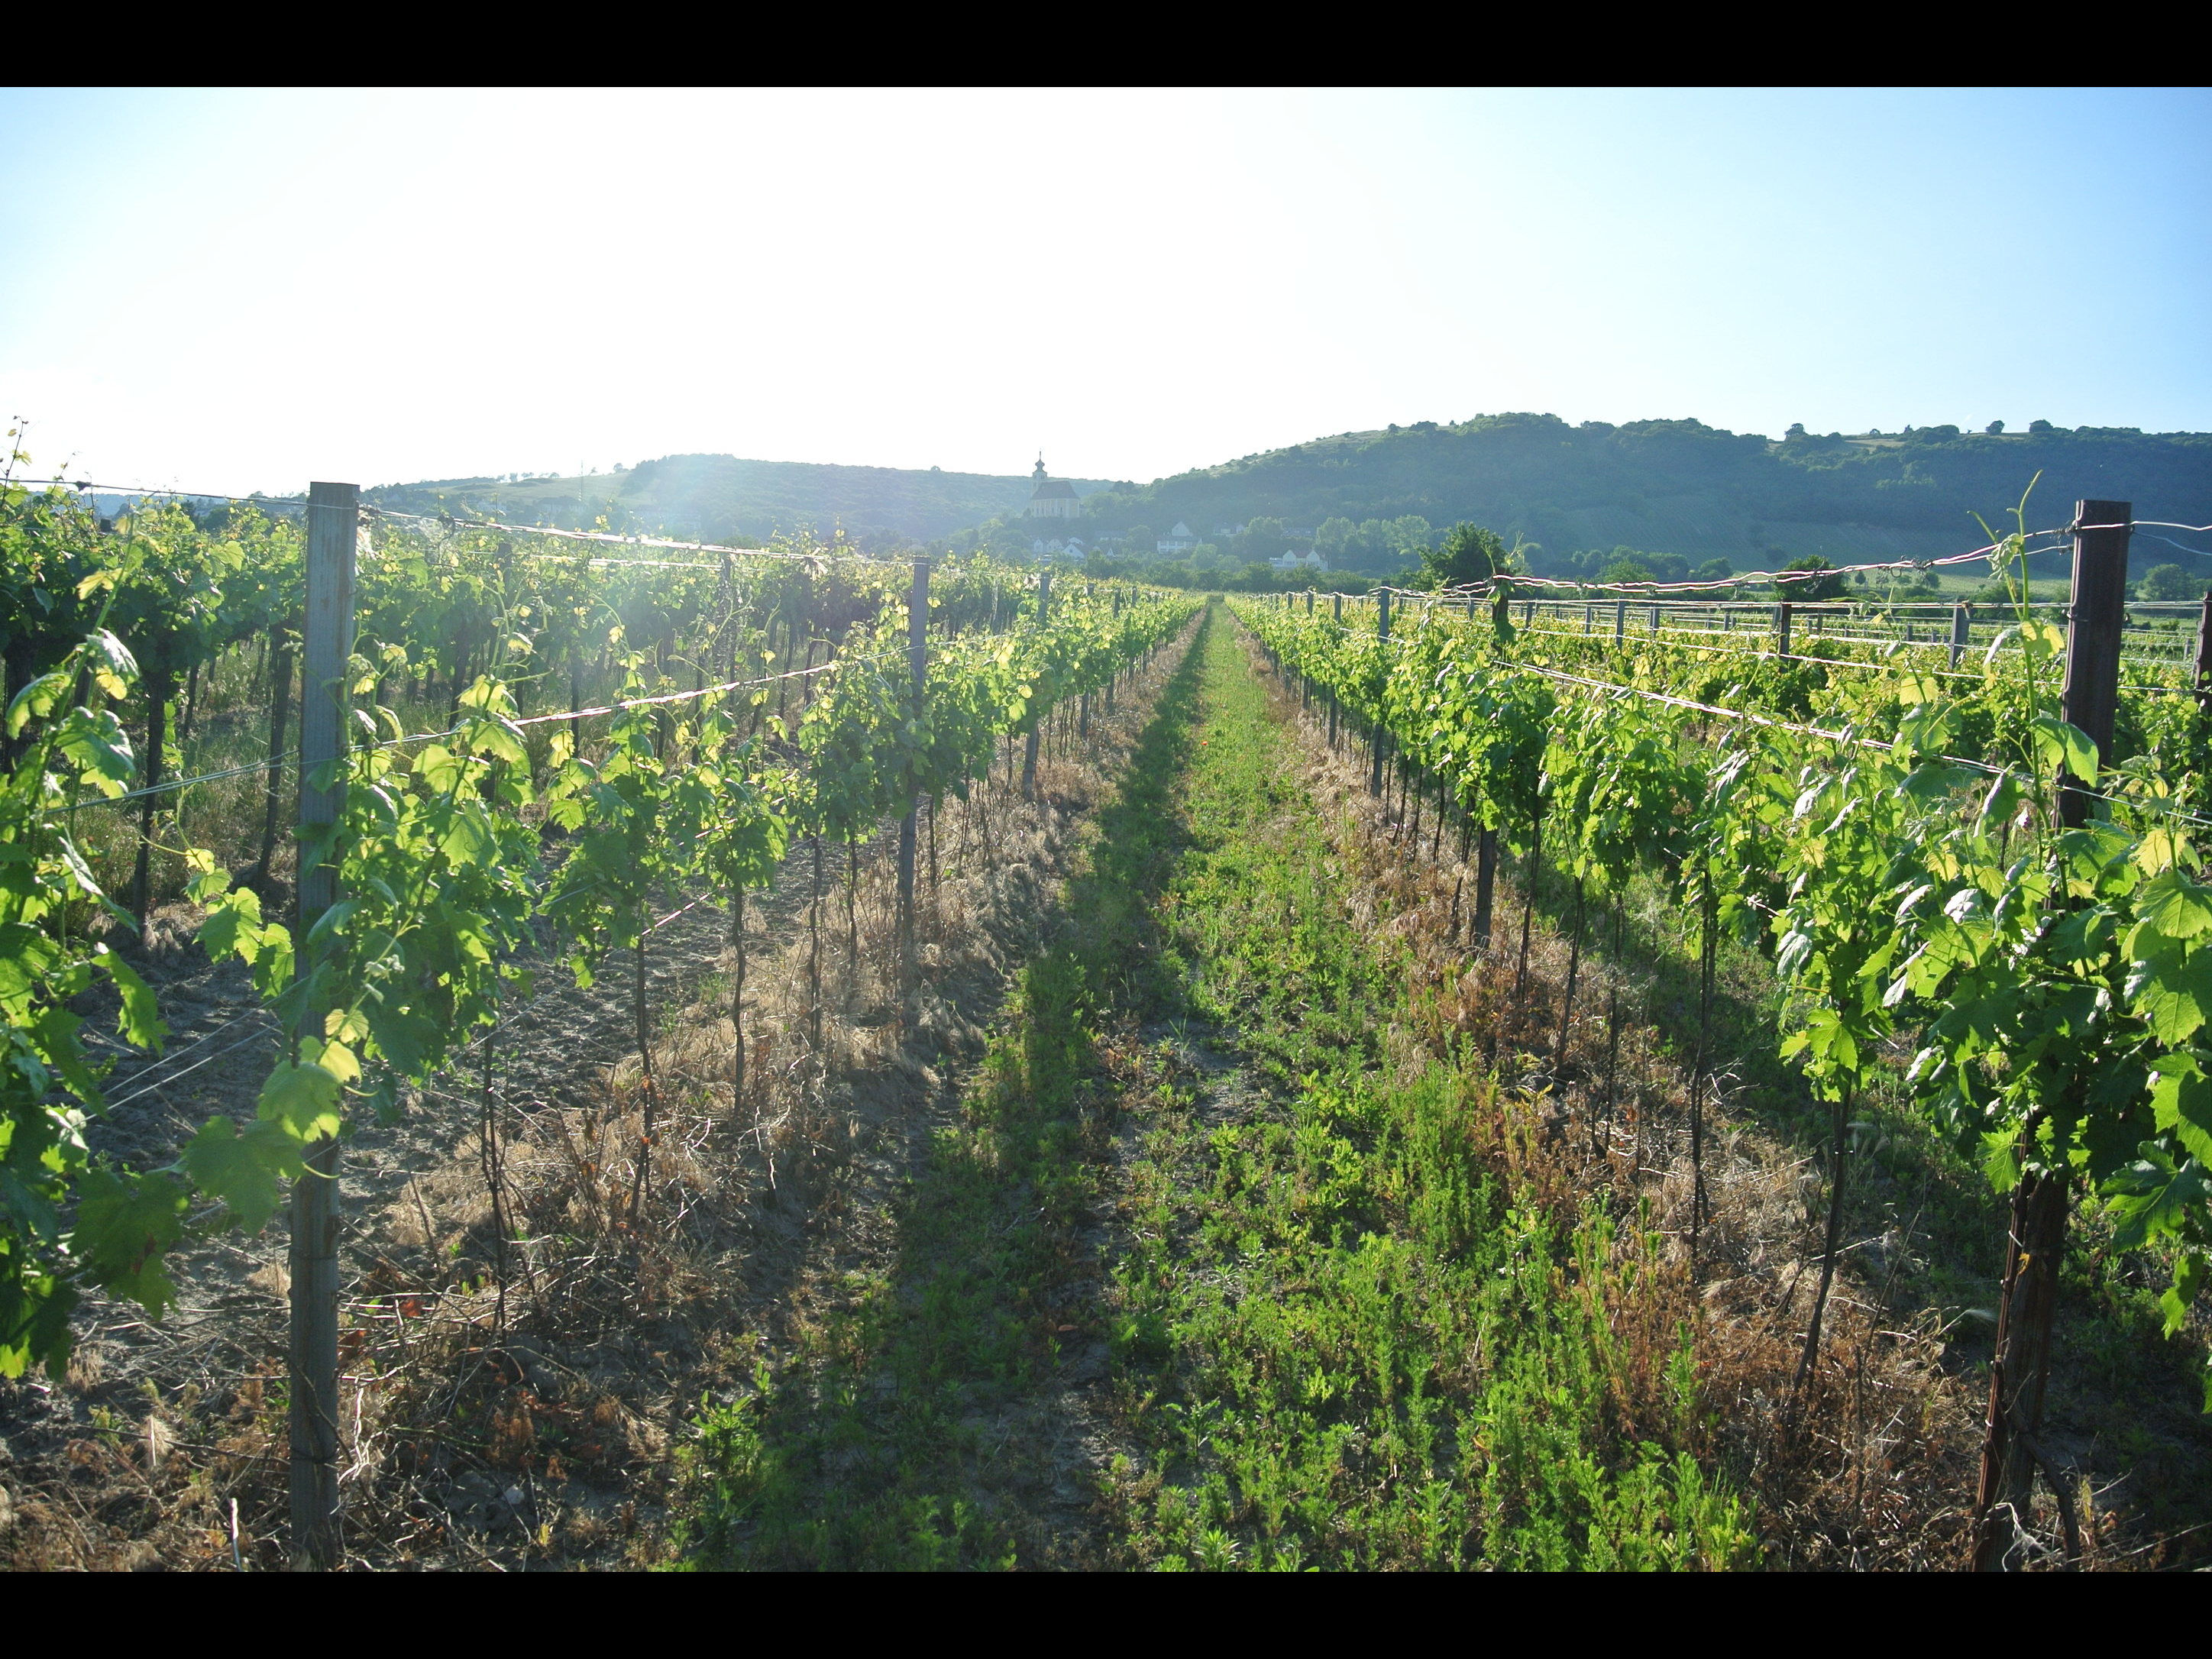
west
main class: Cropland
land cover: Vineyards
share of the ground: 25 - 50 %
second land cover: Spontaneously vegetated surfaces
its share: > 75 %
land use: Agriculture (excluding fallow land and kitchen gardens)
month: June
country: AT
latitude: 47.8961
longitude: 16.6532
